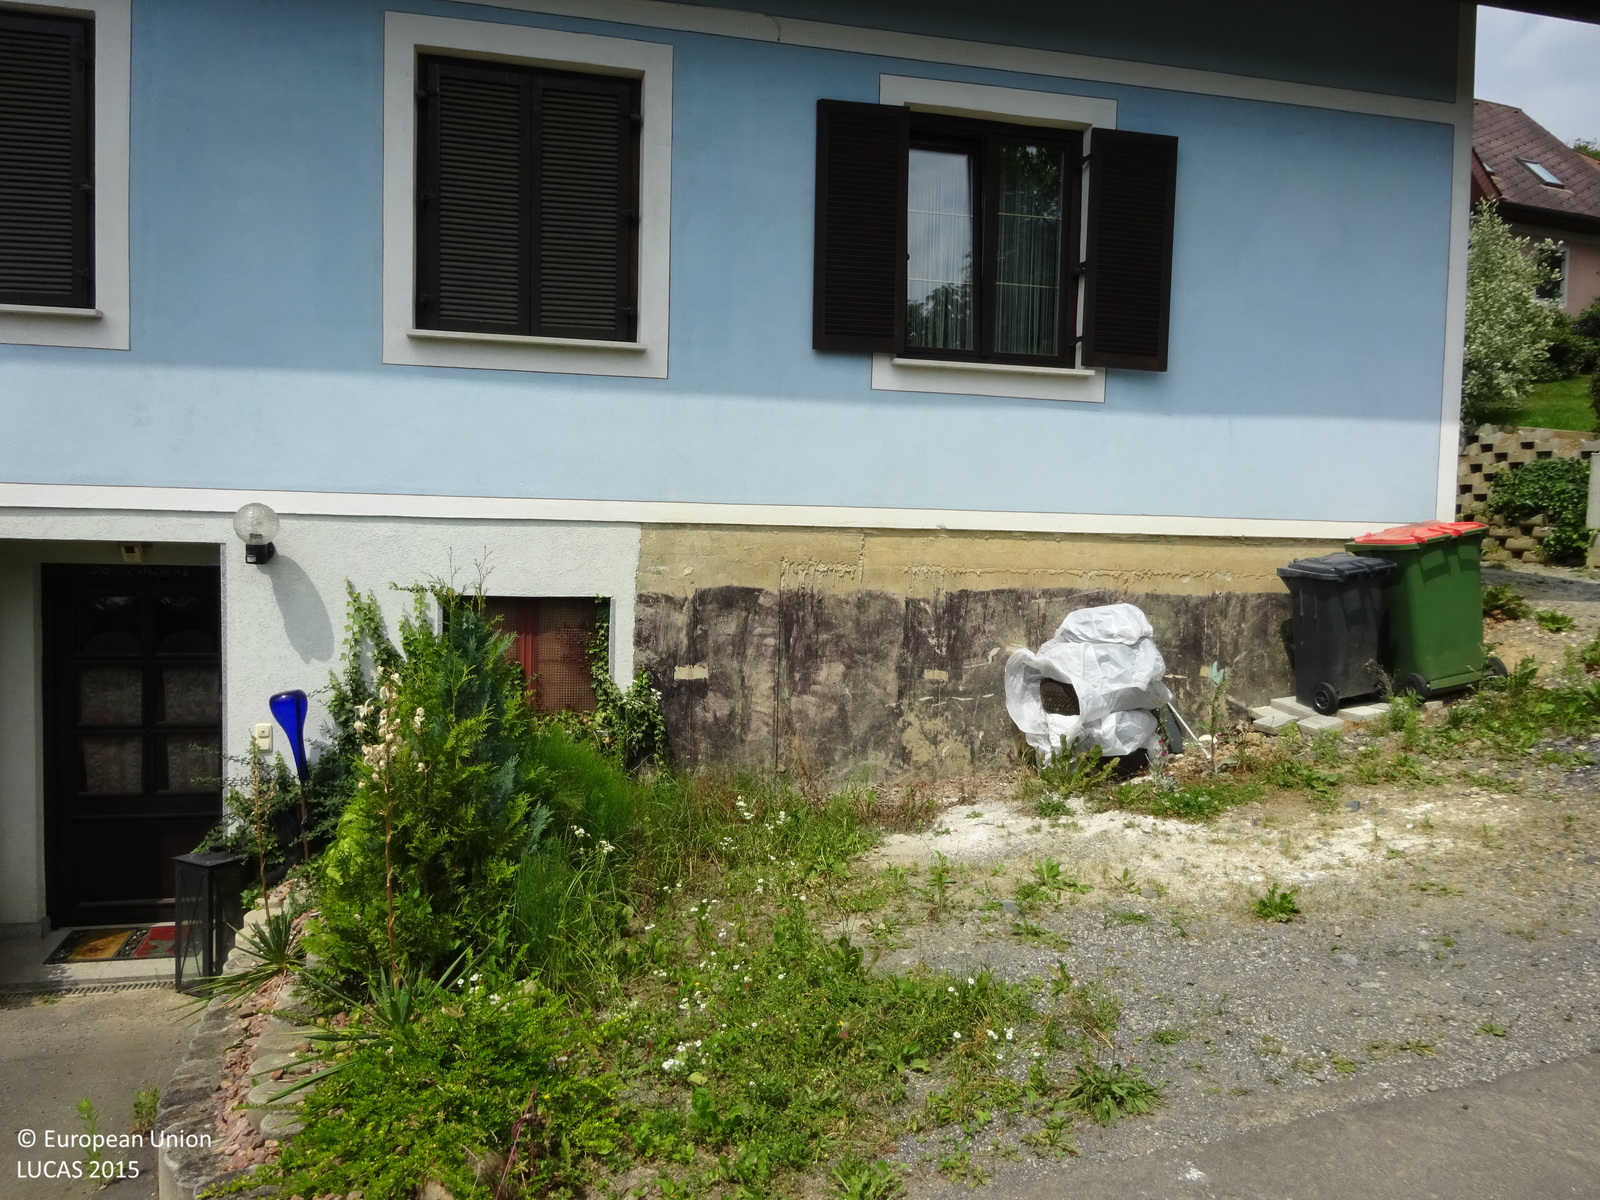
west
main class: Grassland
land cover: Grassland without tree/shrub cover
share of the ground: > 75 %
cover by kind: herbaceous plants 100 %
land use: Residential
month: July
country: AT
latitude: 46.9094
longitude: 15.9218
